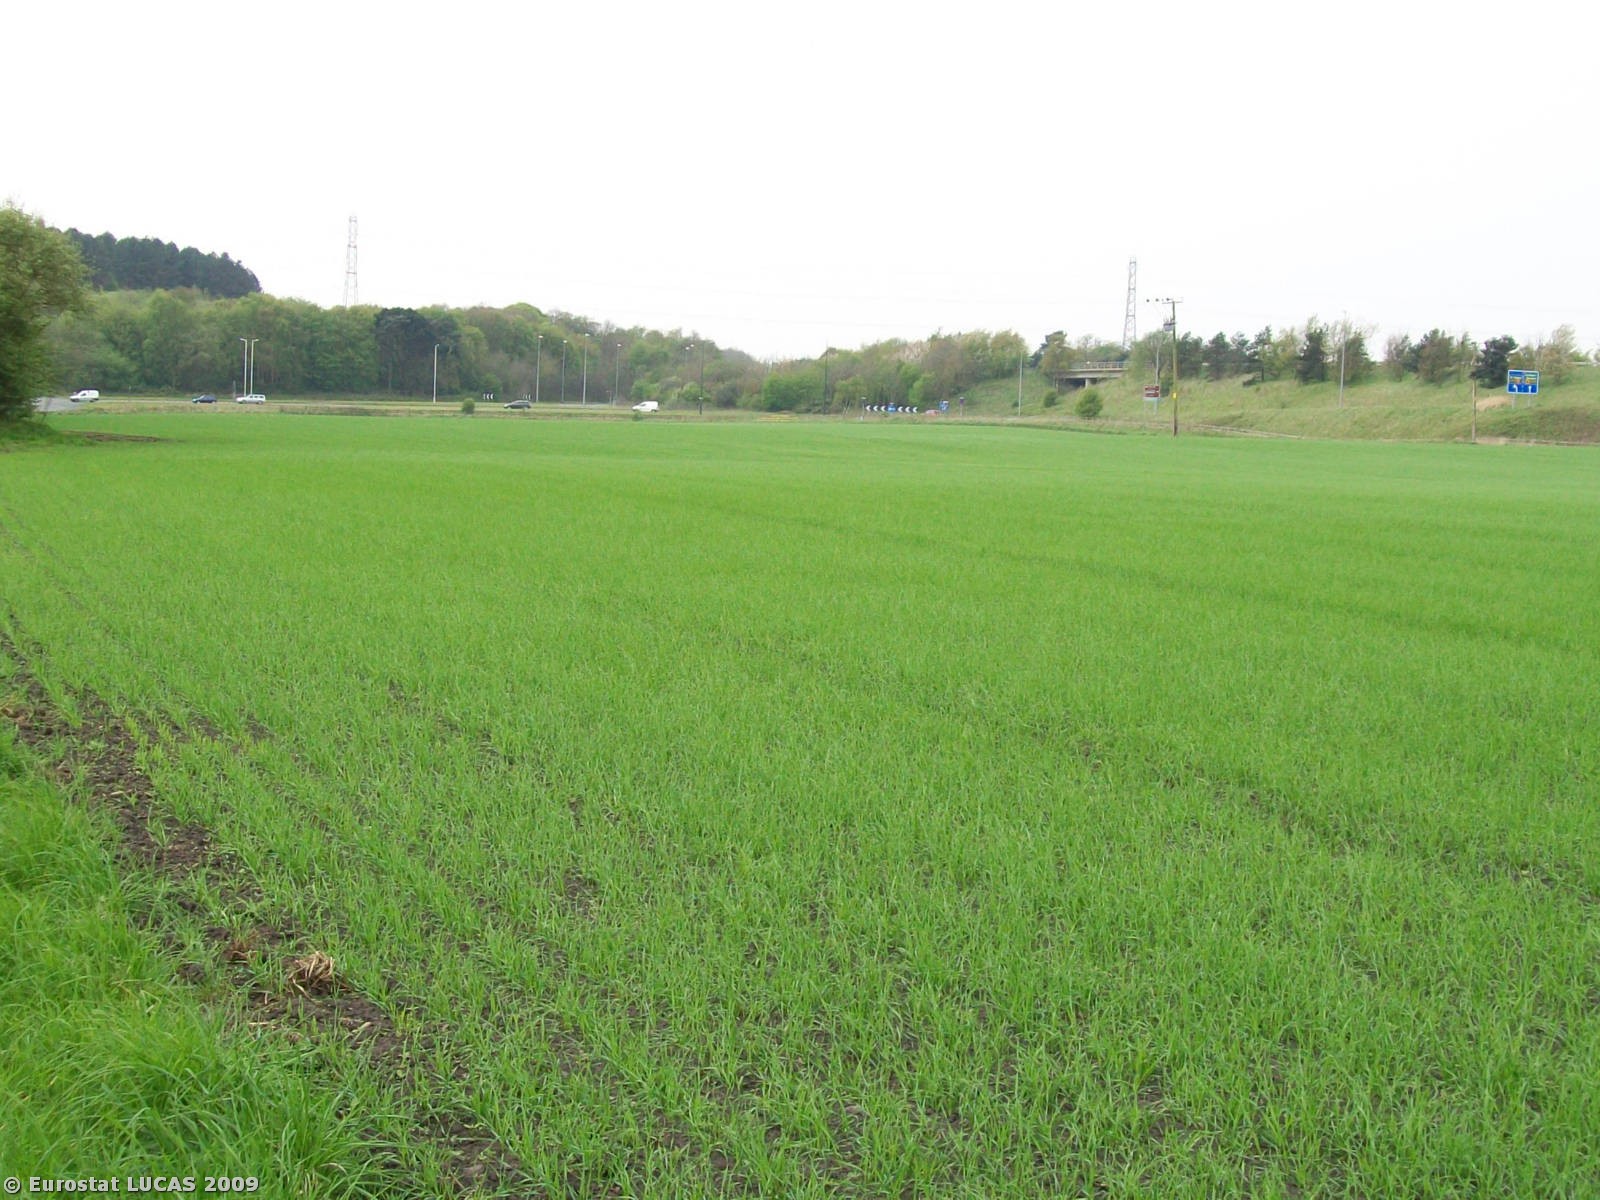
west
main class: Cropland
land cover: Common wheat
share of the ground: 50 - 75 %
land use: Agriculture (excluding fallow land and kitchen gardens)
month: April
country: GB
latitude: 53.5366
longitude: -2.8207
